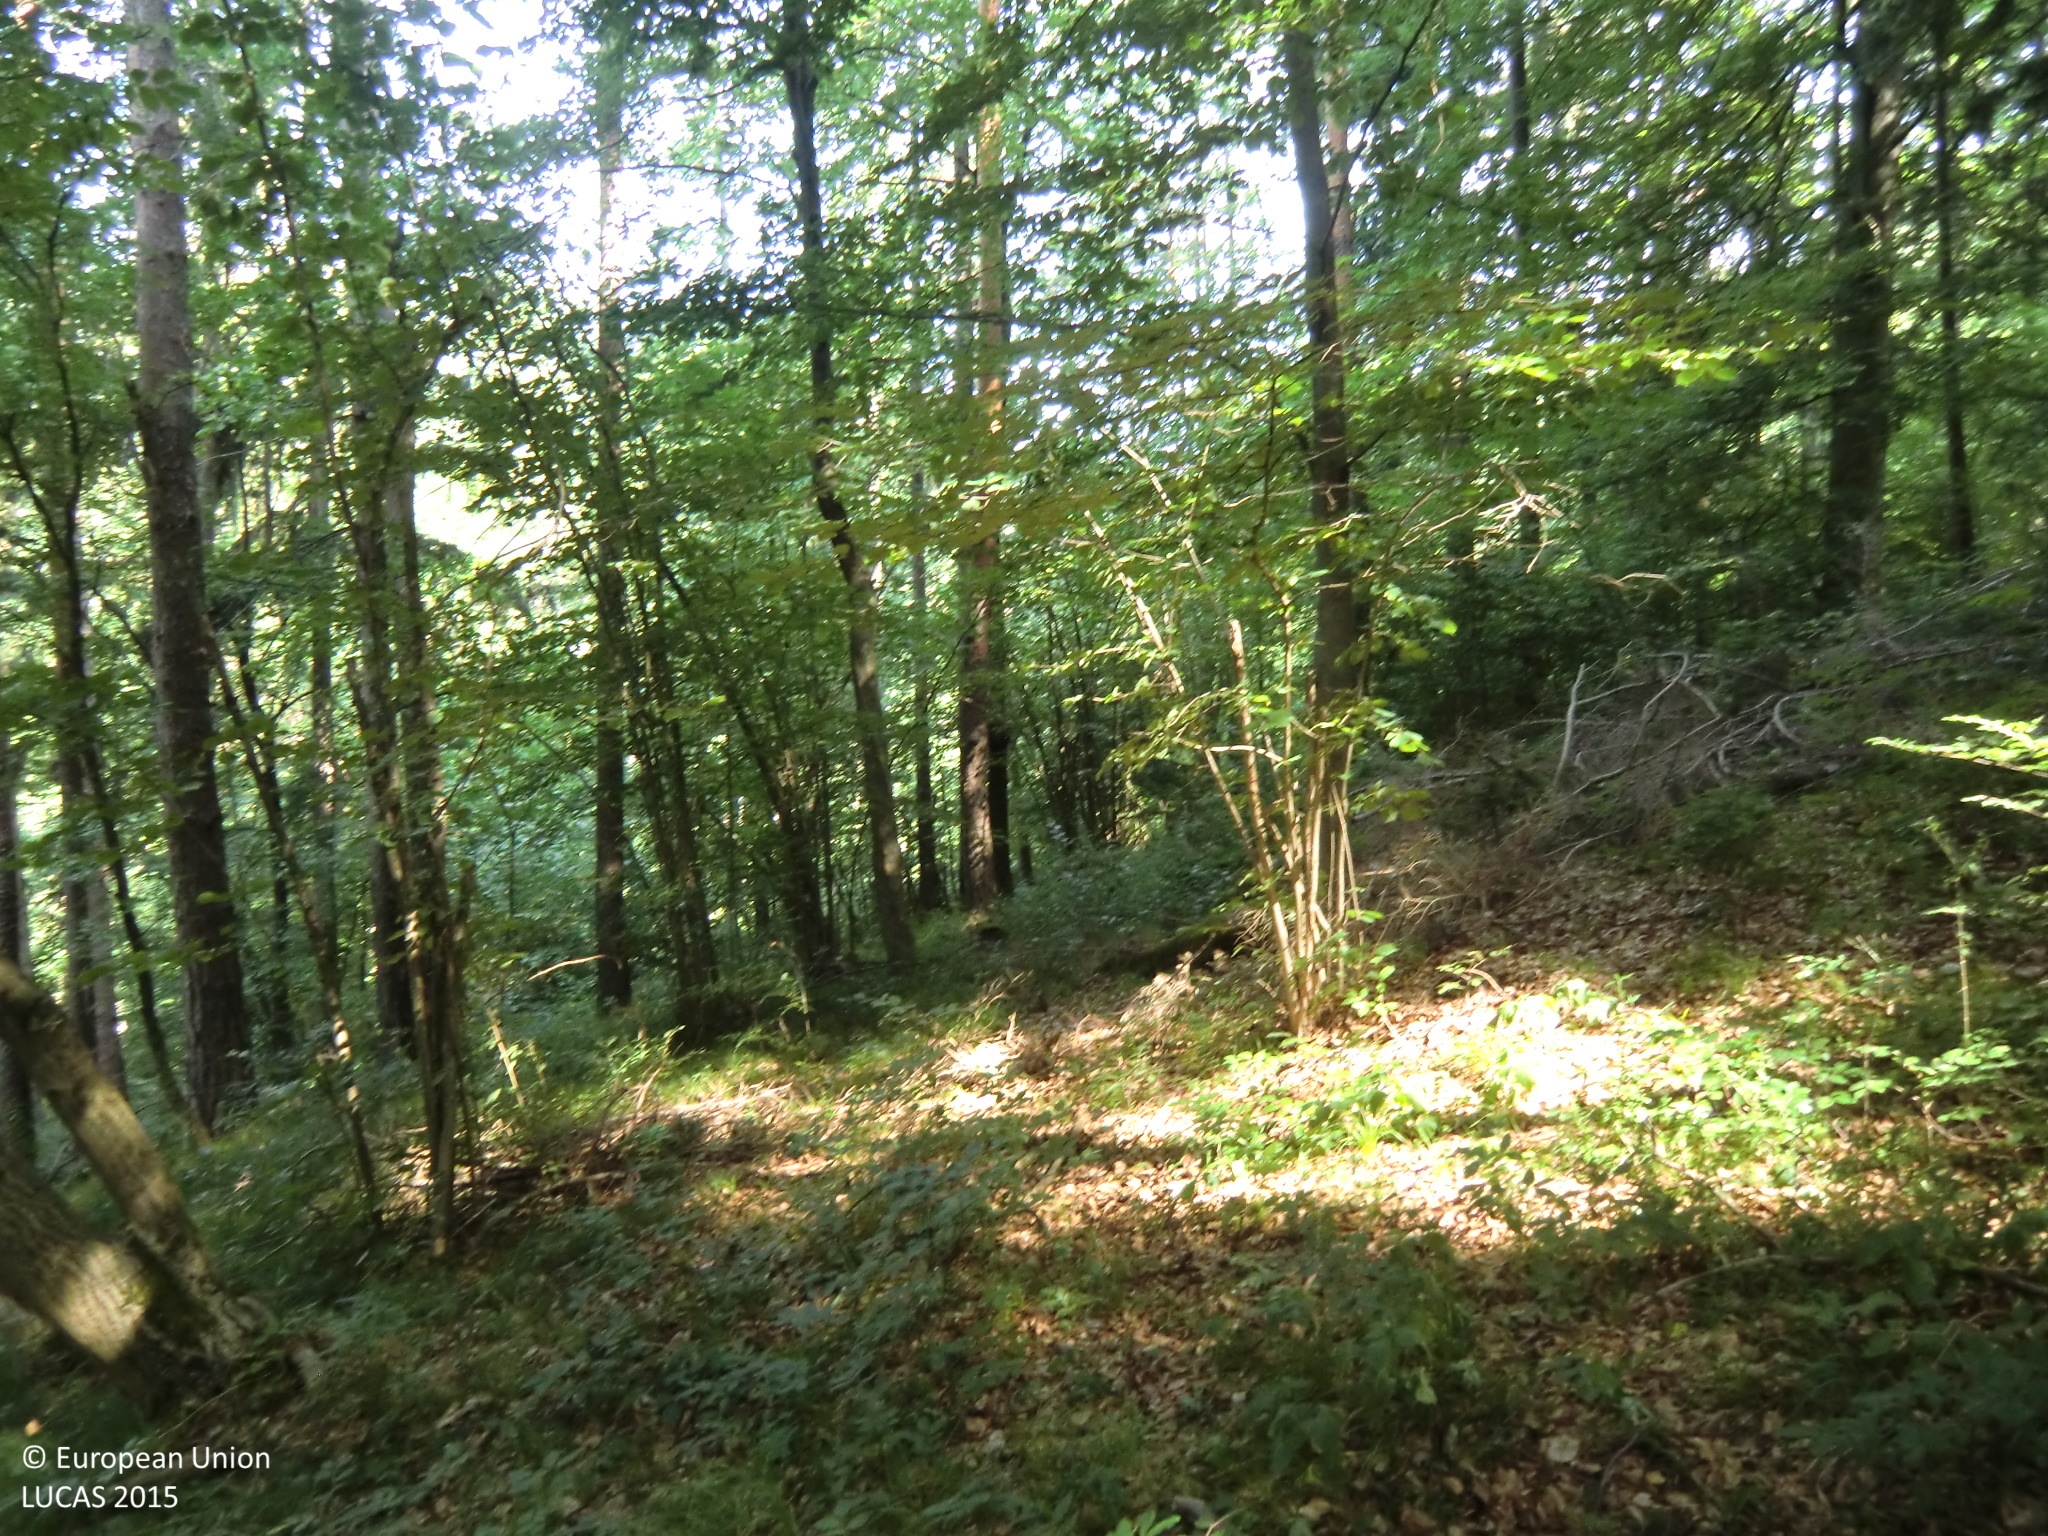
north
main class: Woodland
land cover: Other mixed woodland
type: hemiboreal forest and nemoral coniferous forest and mixed broadleaved-coniferous forest
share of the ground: > 75 %
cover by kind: coniferous forest trees 45 %, broadleaved forest trees 40 %, herbaceous plants 10 %, unconsolidated bare surface 5 %
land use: Forestry
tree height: > 5 m
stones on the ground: < 10 %
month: July
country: AT
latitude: 47.1522
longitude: 15.4205
